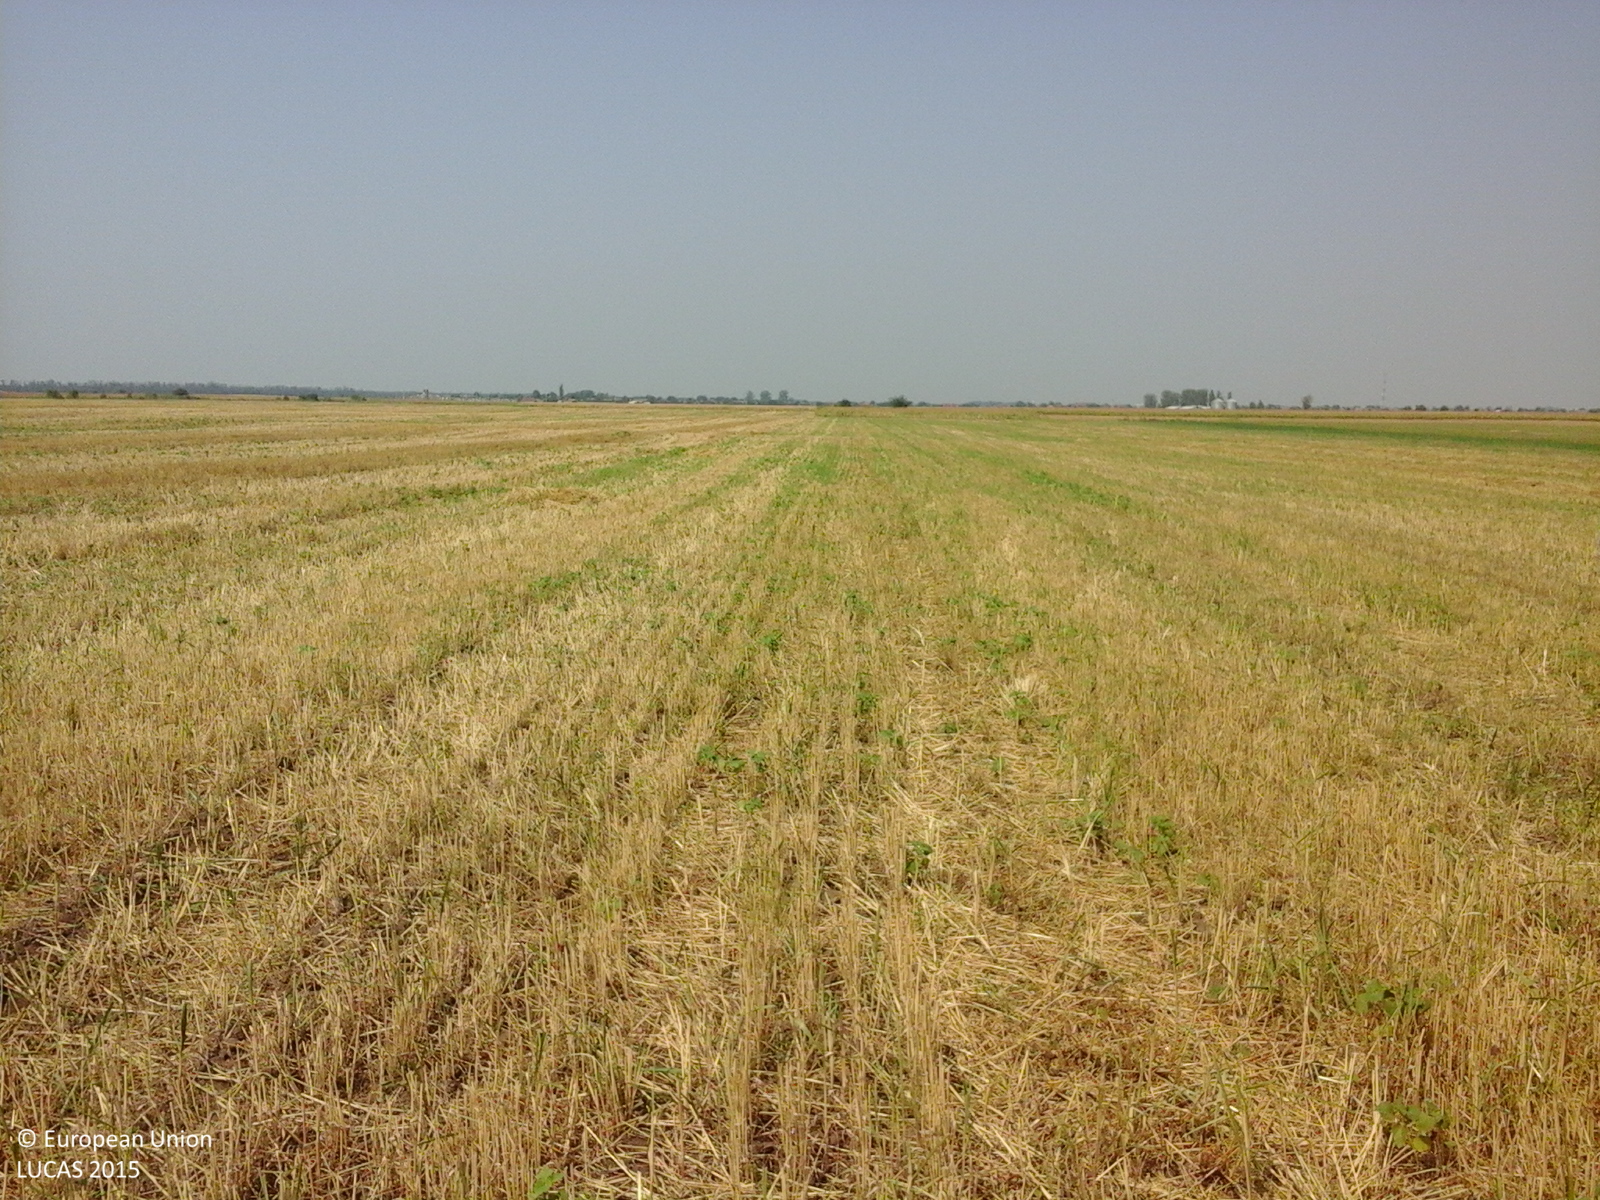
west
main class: Cropland
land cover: Common wheat
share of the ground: > 75 %
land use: Agriculture (excluding fallow land and kitchen gardens)
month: August
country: RO
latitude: 43.8833
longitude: 23.2247
